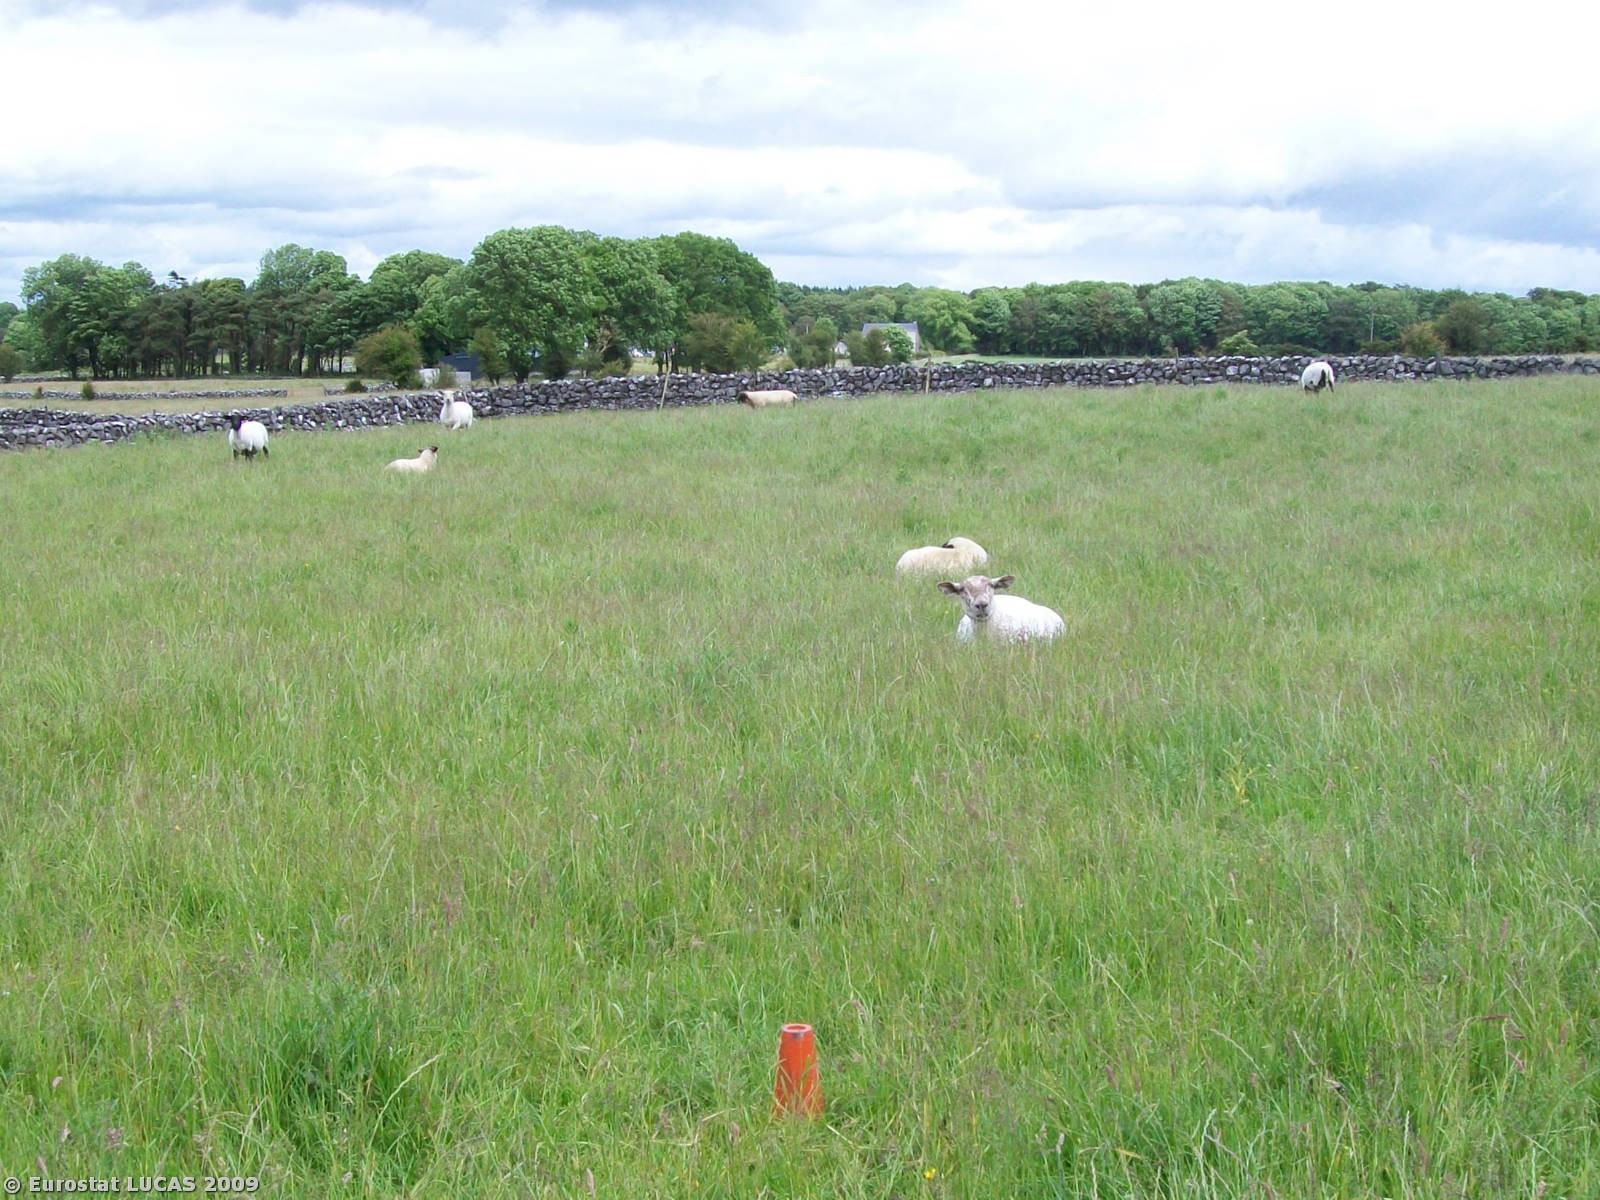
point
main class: Grassland
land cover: Grassland without tree/shrub cover
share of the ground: > 75 %
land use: Agriculture (excluding fallow land and kitchen gardens)
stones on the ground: < 10 %
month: June
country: IE
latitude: 53.3366
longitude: -8.7810
